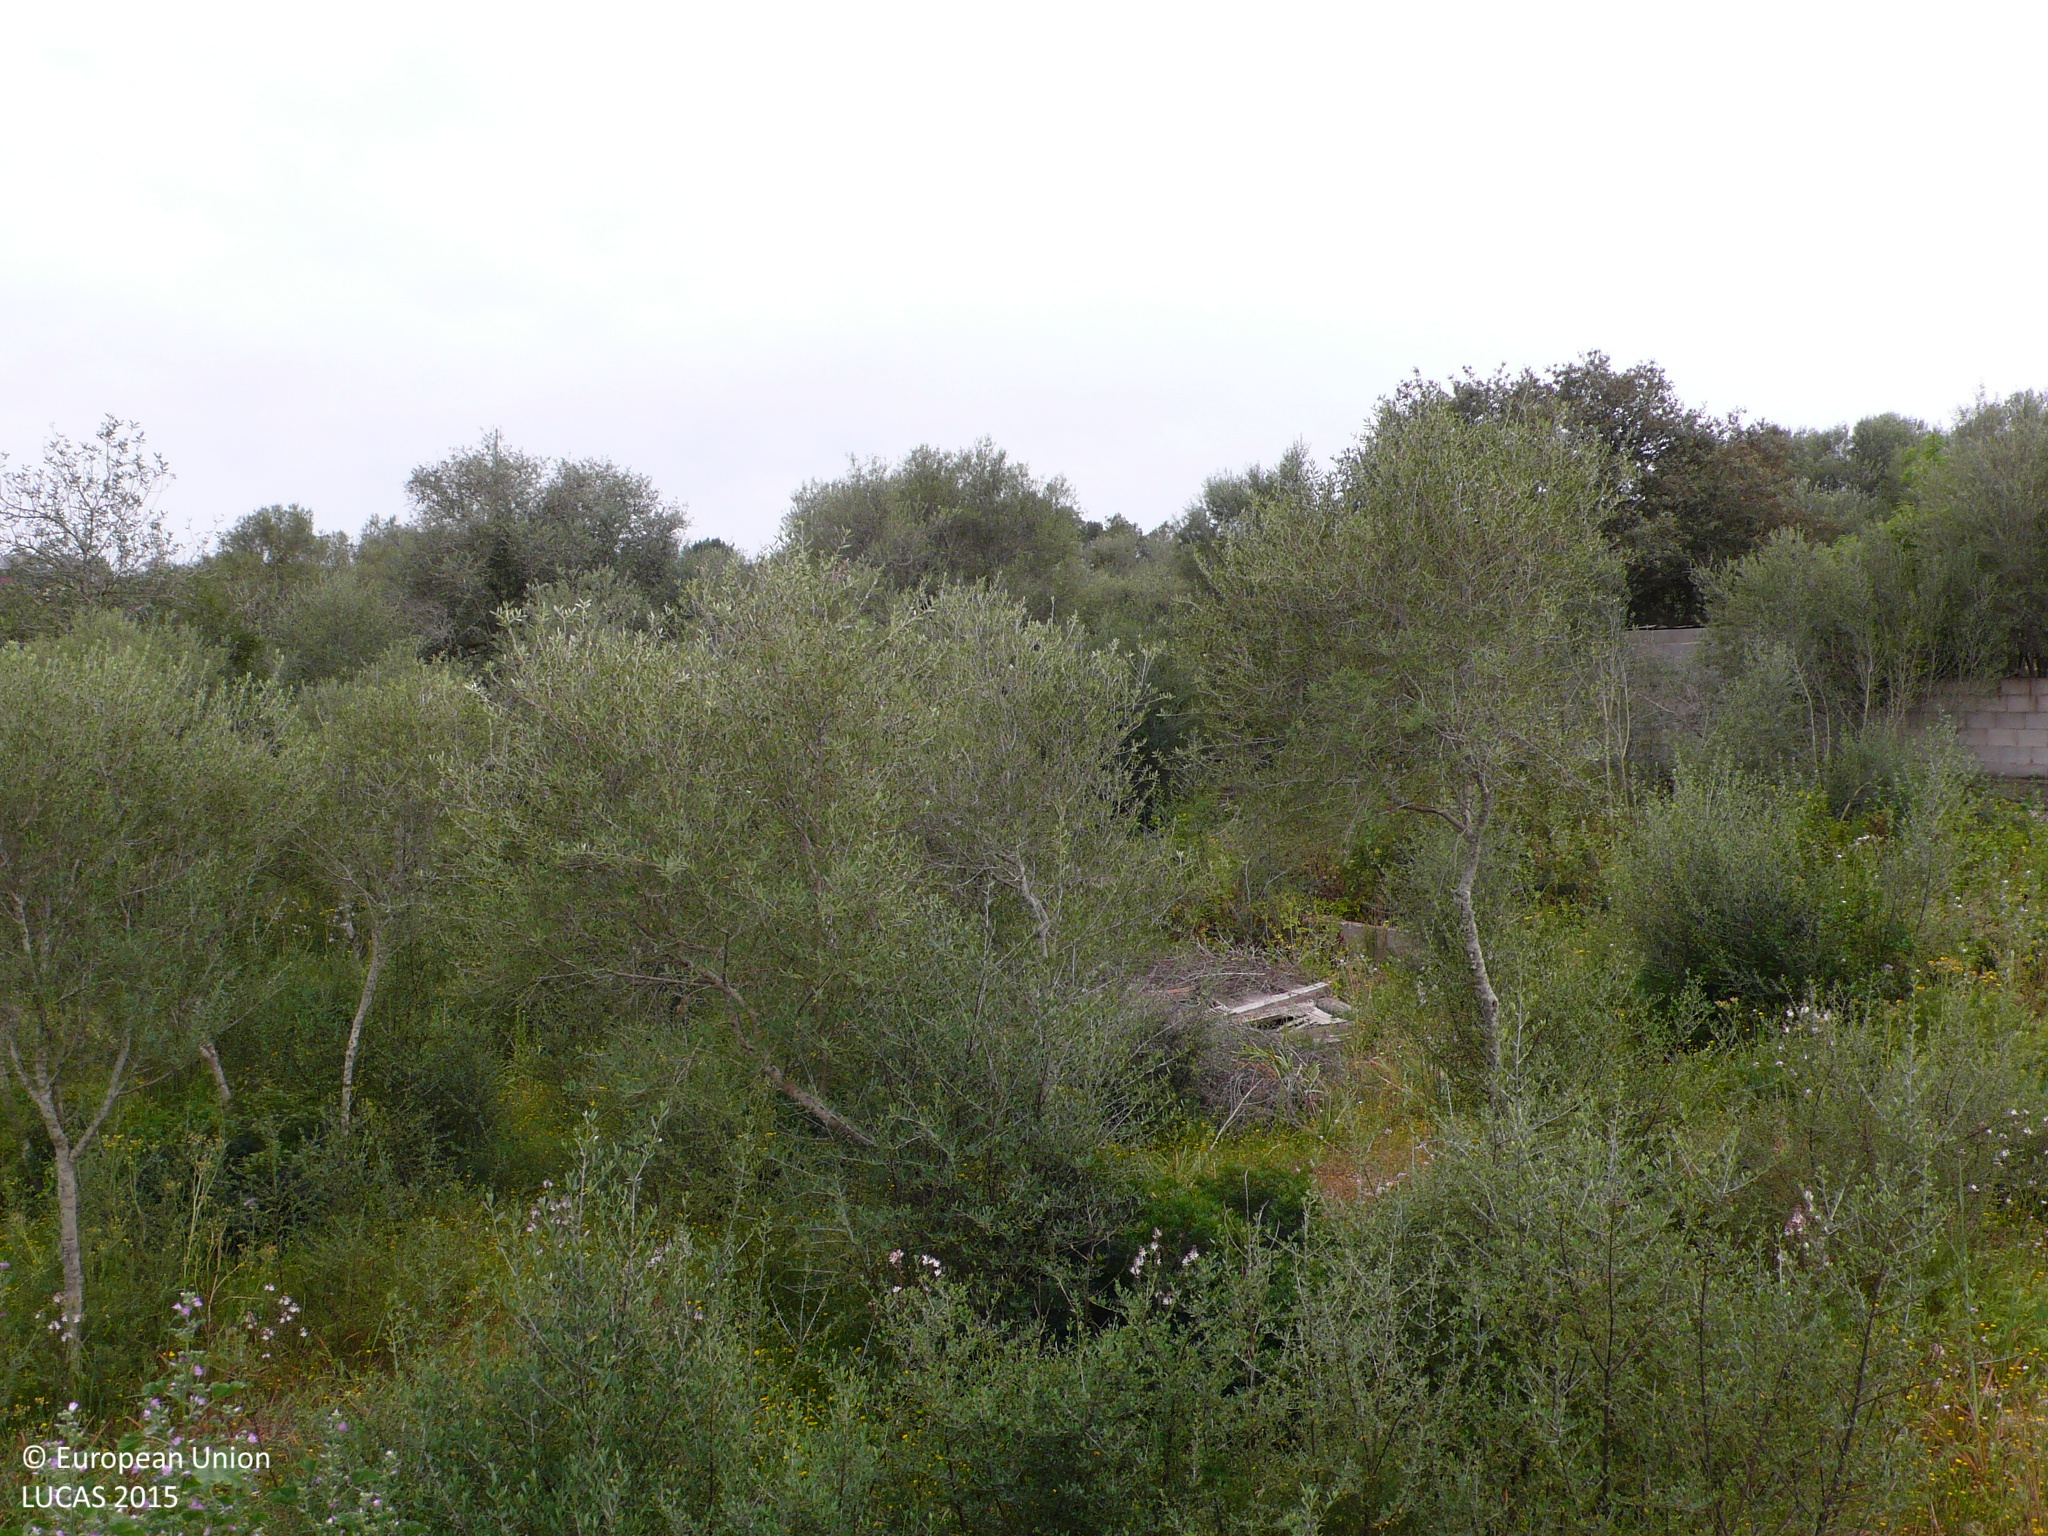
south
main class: Woodland
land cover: Broadleaved woodland
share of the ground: 25 - 50 %
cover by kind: broadleaved forest trees 40 %, shrubs 35 %, herbaceous plants 15 %, unconsolidated bare surface 10 %
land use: Abandoned areas
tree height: < 5 m
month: April
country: ES
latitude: 39.6455
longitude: 2.8864
